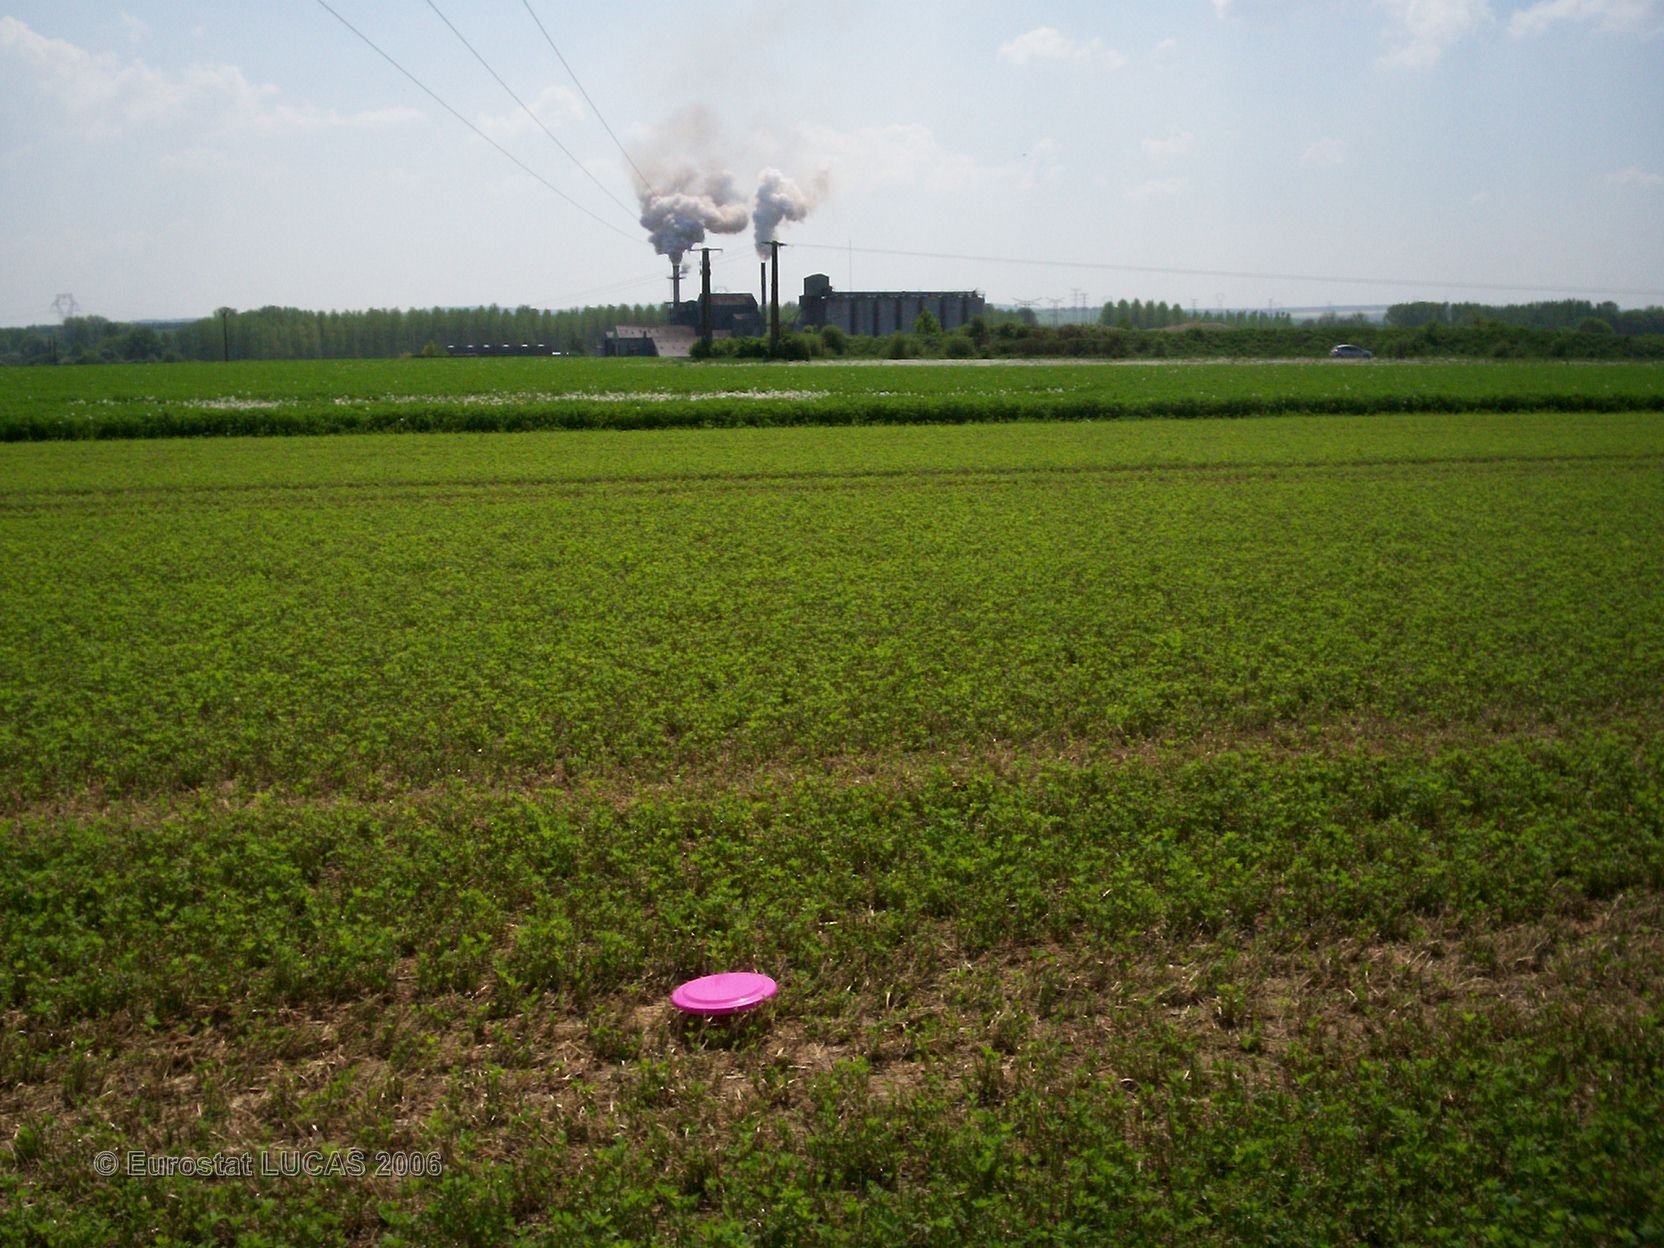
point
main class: Cropland
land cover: Lucerne
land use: Agriculture (excluding fallow land and kitchen gardens)
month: May
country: FR
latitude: 49.3047
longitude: 4.3434
